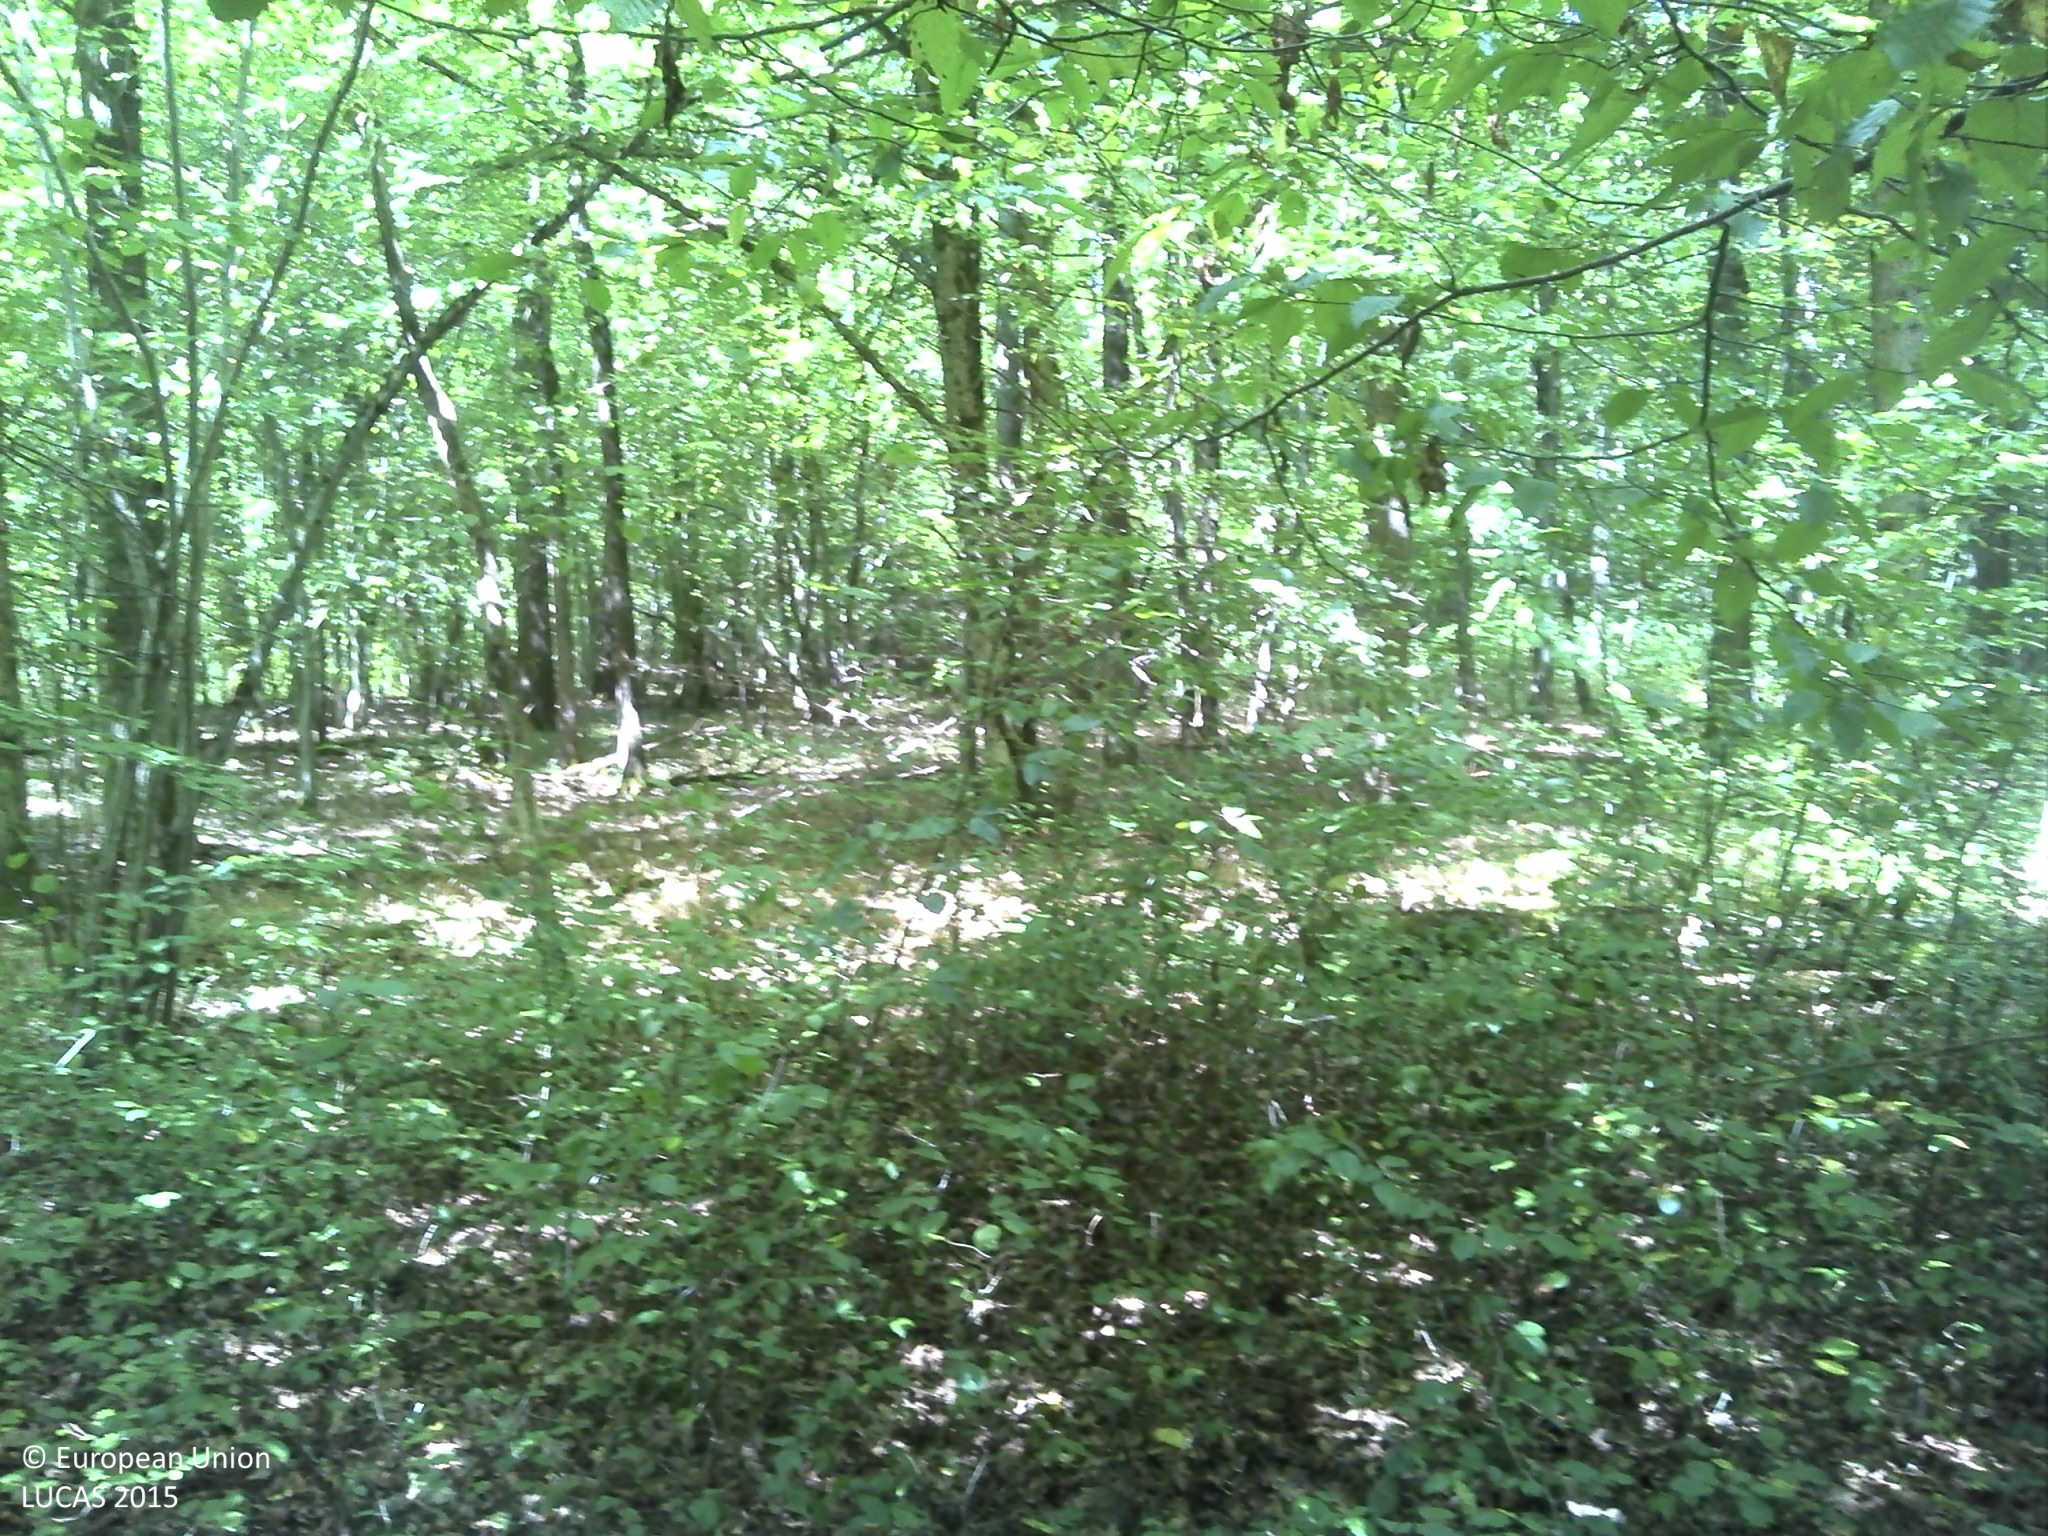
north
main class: Woodland
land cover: Broadleaved woodland
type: mesophytic deciduous forest
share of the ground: > 75 %
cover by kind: broadleaved forest trees 75 %, herbaceous plants 15 %, shrubs 10 %
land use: Forestry
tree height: > 5 m
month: July
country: FR
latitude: 45.7923
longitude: 4.1234
